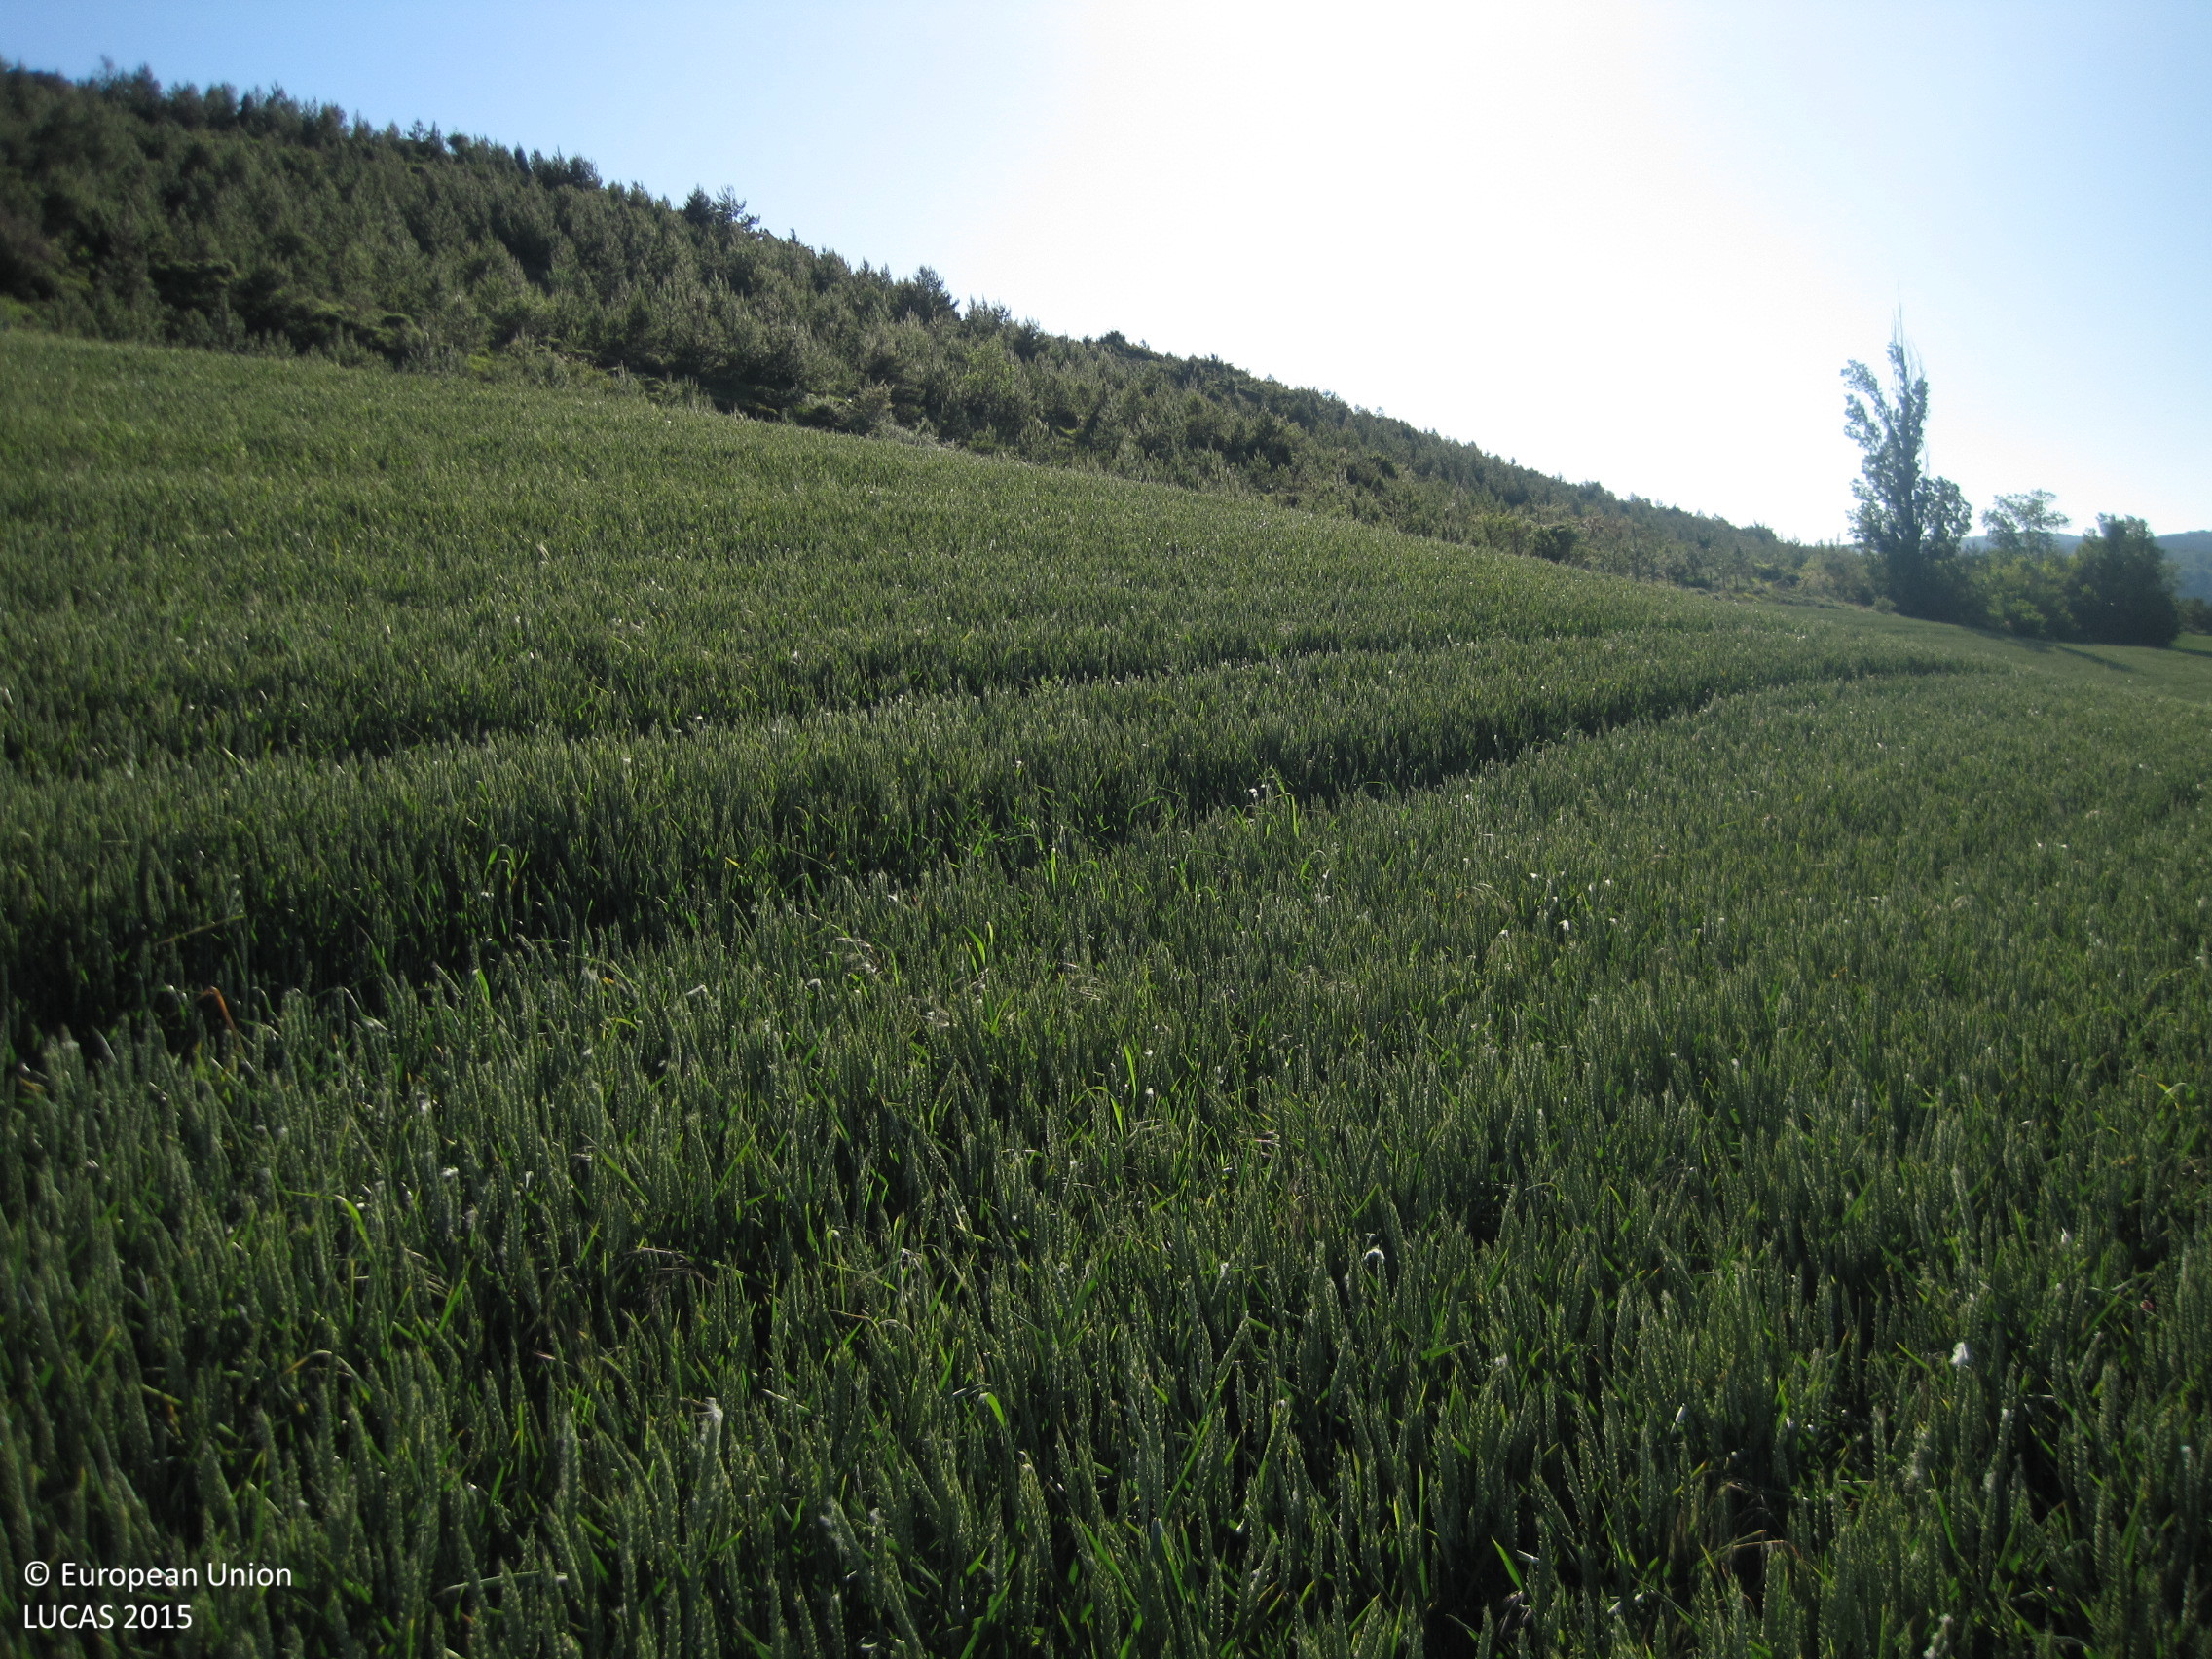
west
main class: Cropland
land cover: Common wheat
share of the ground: > 75 %
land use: Agriculture (excluding fallow land and kitchen gardens)
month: May
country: ES
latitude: 42.7484
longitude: -1.4595
